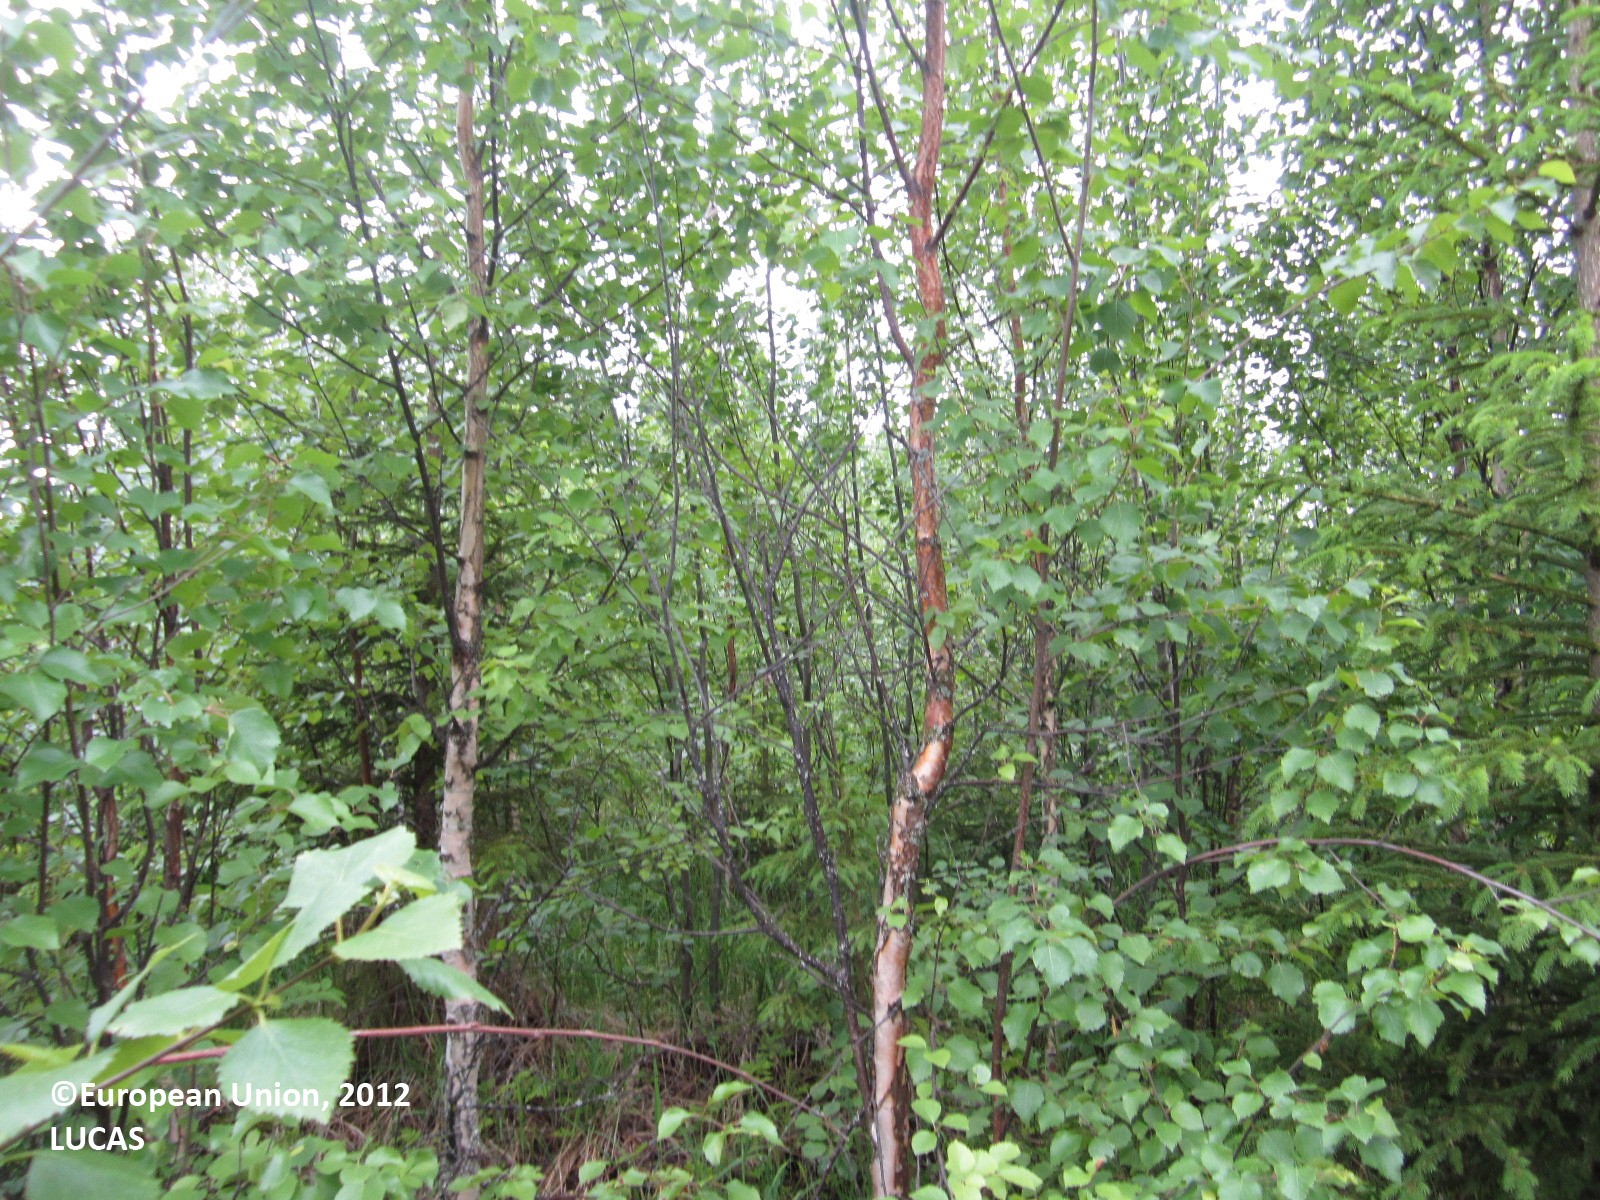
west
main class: Woodland
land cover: Broadleaved woodland
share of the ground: > 75 %
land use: Forestry
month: June
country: FI
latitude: 64.3097
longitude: 29.8077
